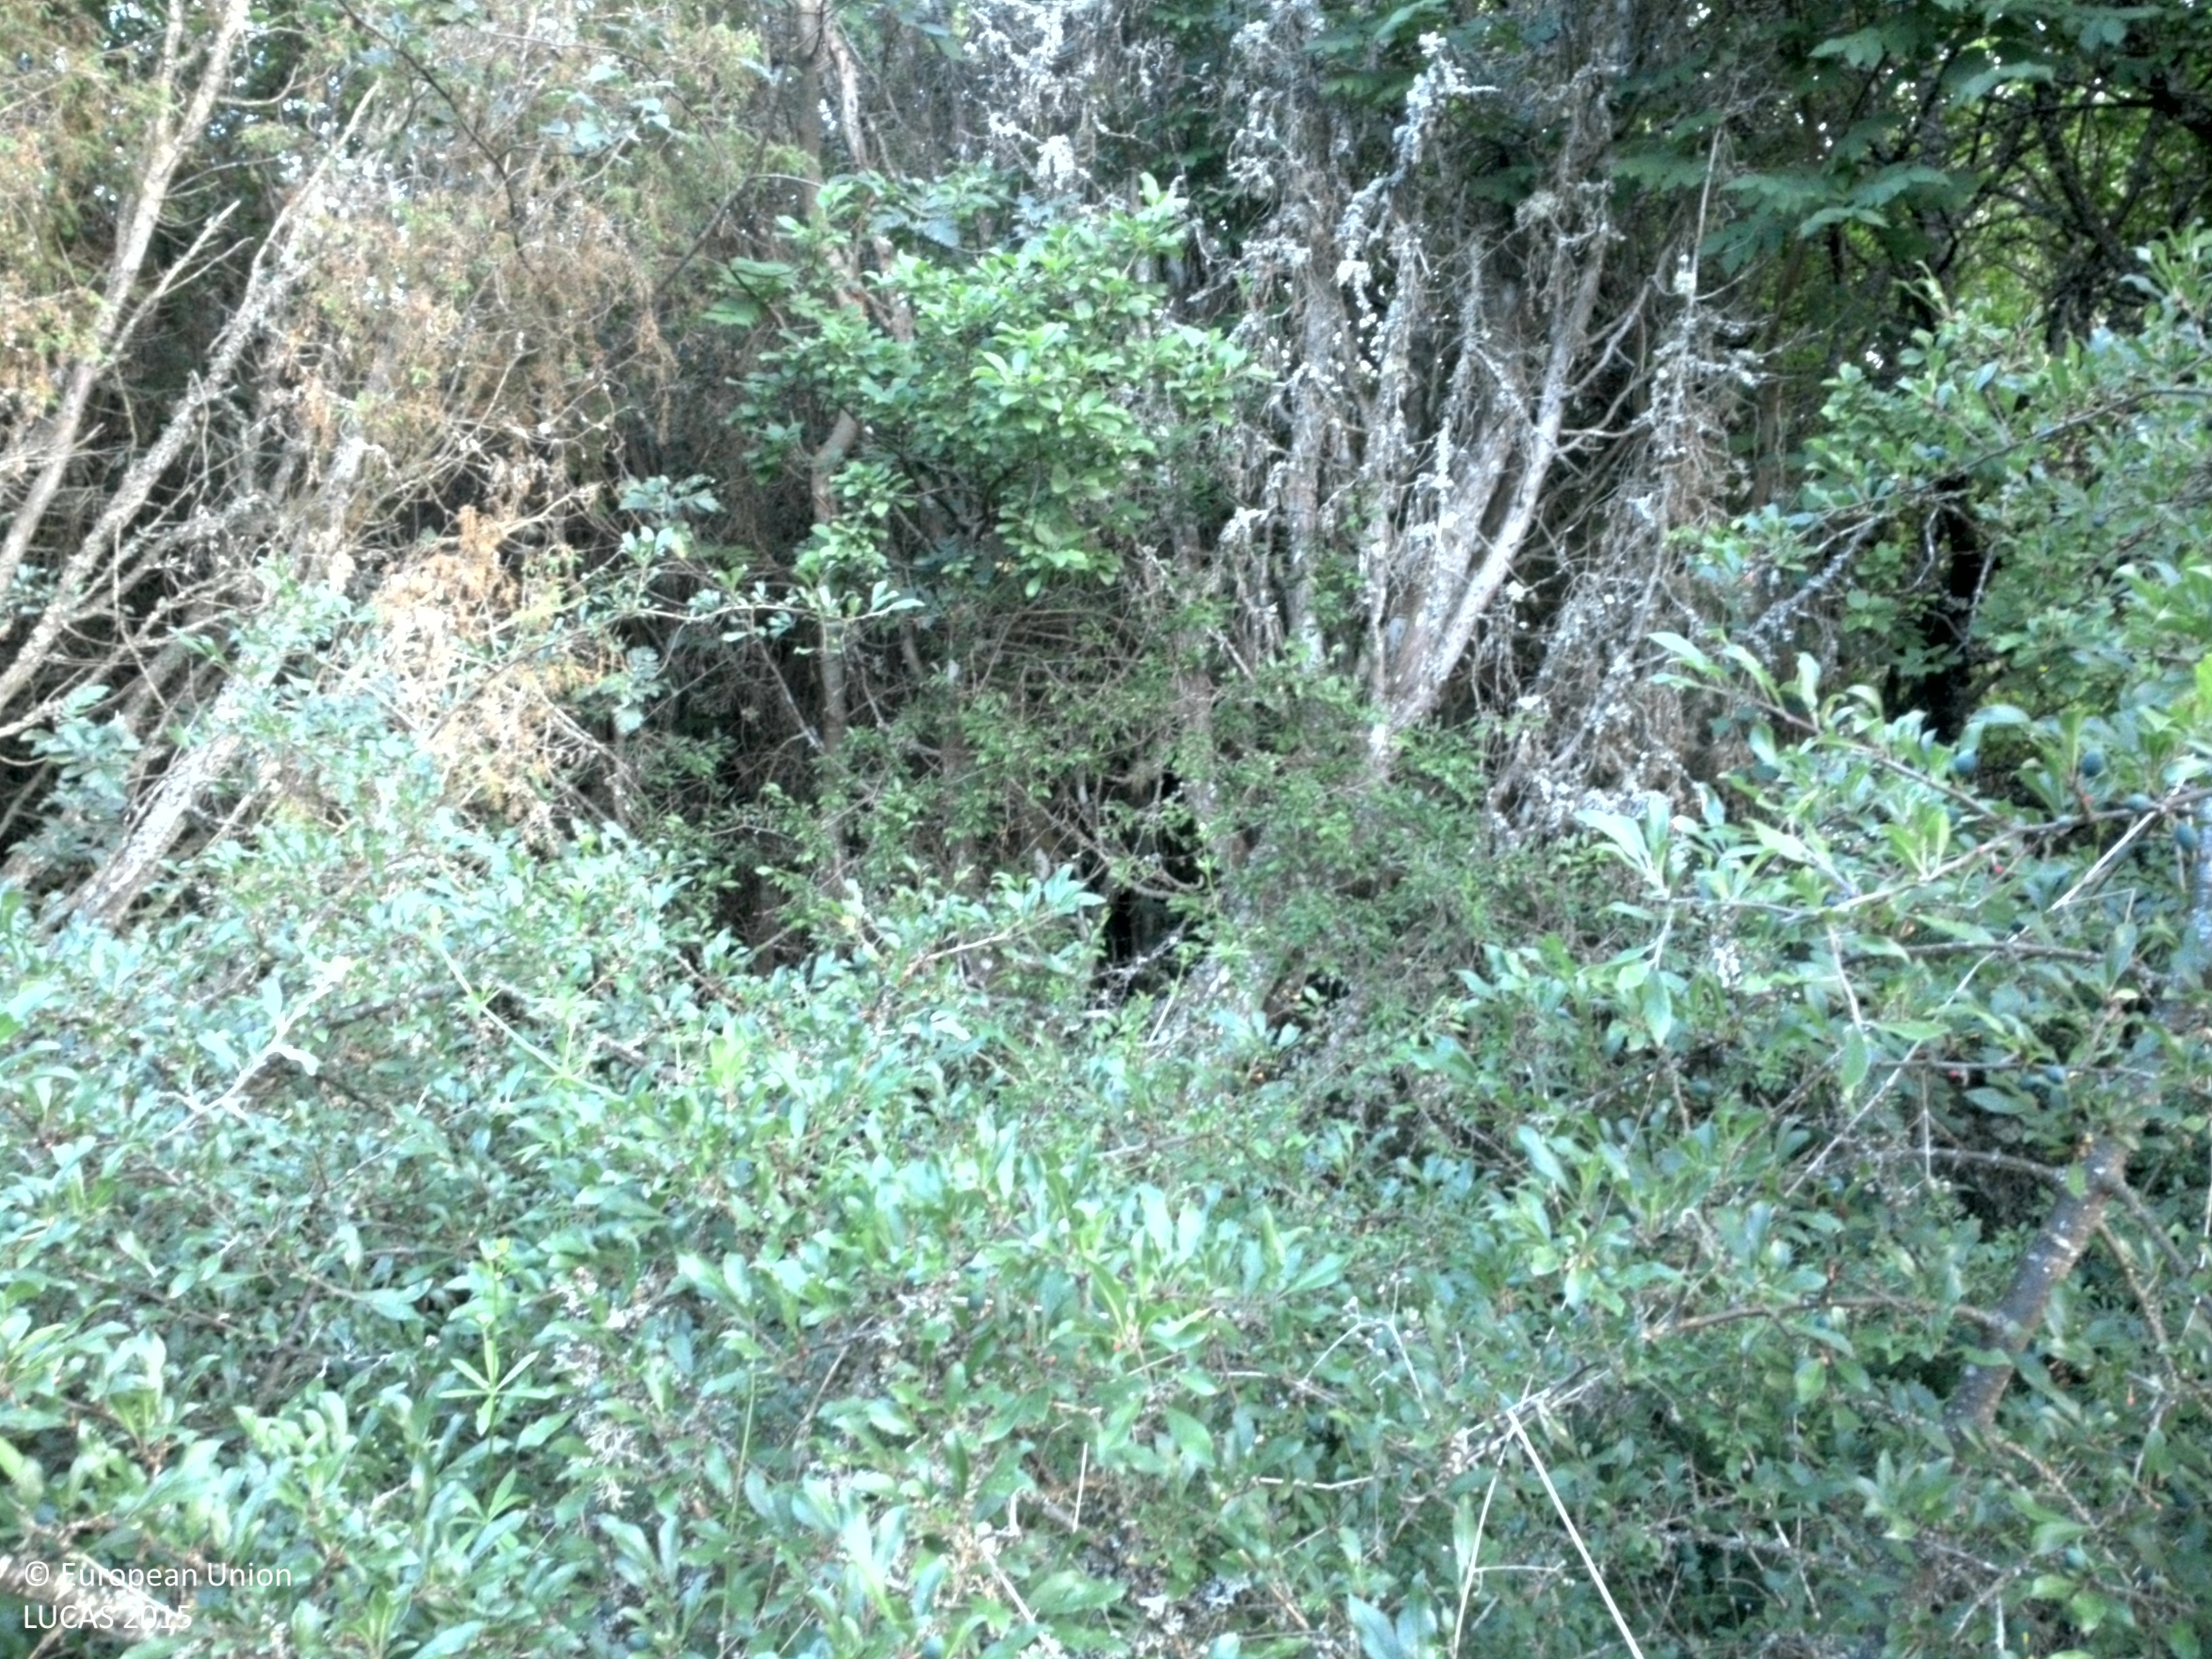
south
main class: Shrubland
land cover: Shrubland with sparse tree cover
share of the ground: > 75 %
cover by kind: shrubs 95 %, broadleaved forest trees 5 %
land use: Amenities, museums, leisure
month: July
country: SE
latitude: 57.6427
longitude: 18.7716
